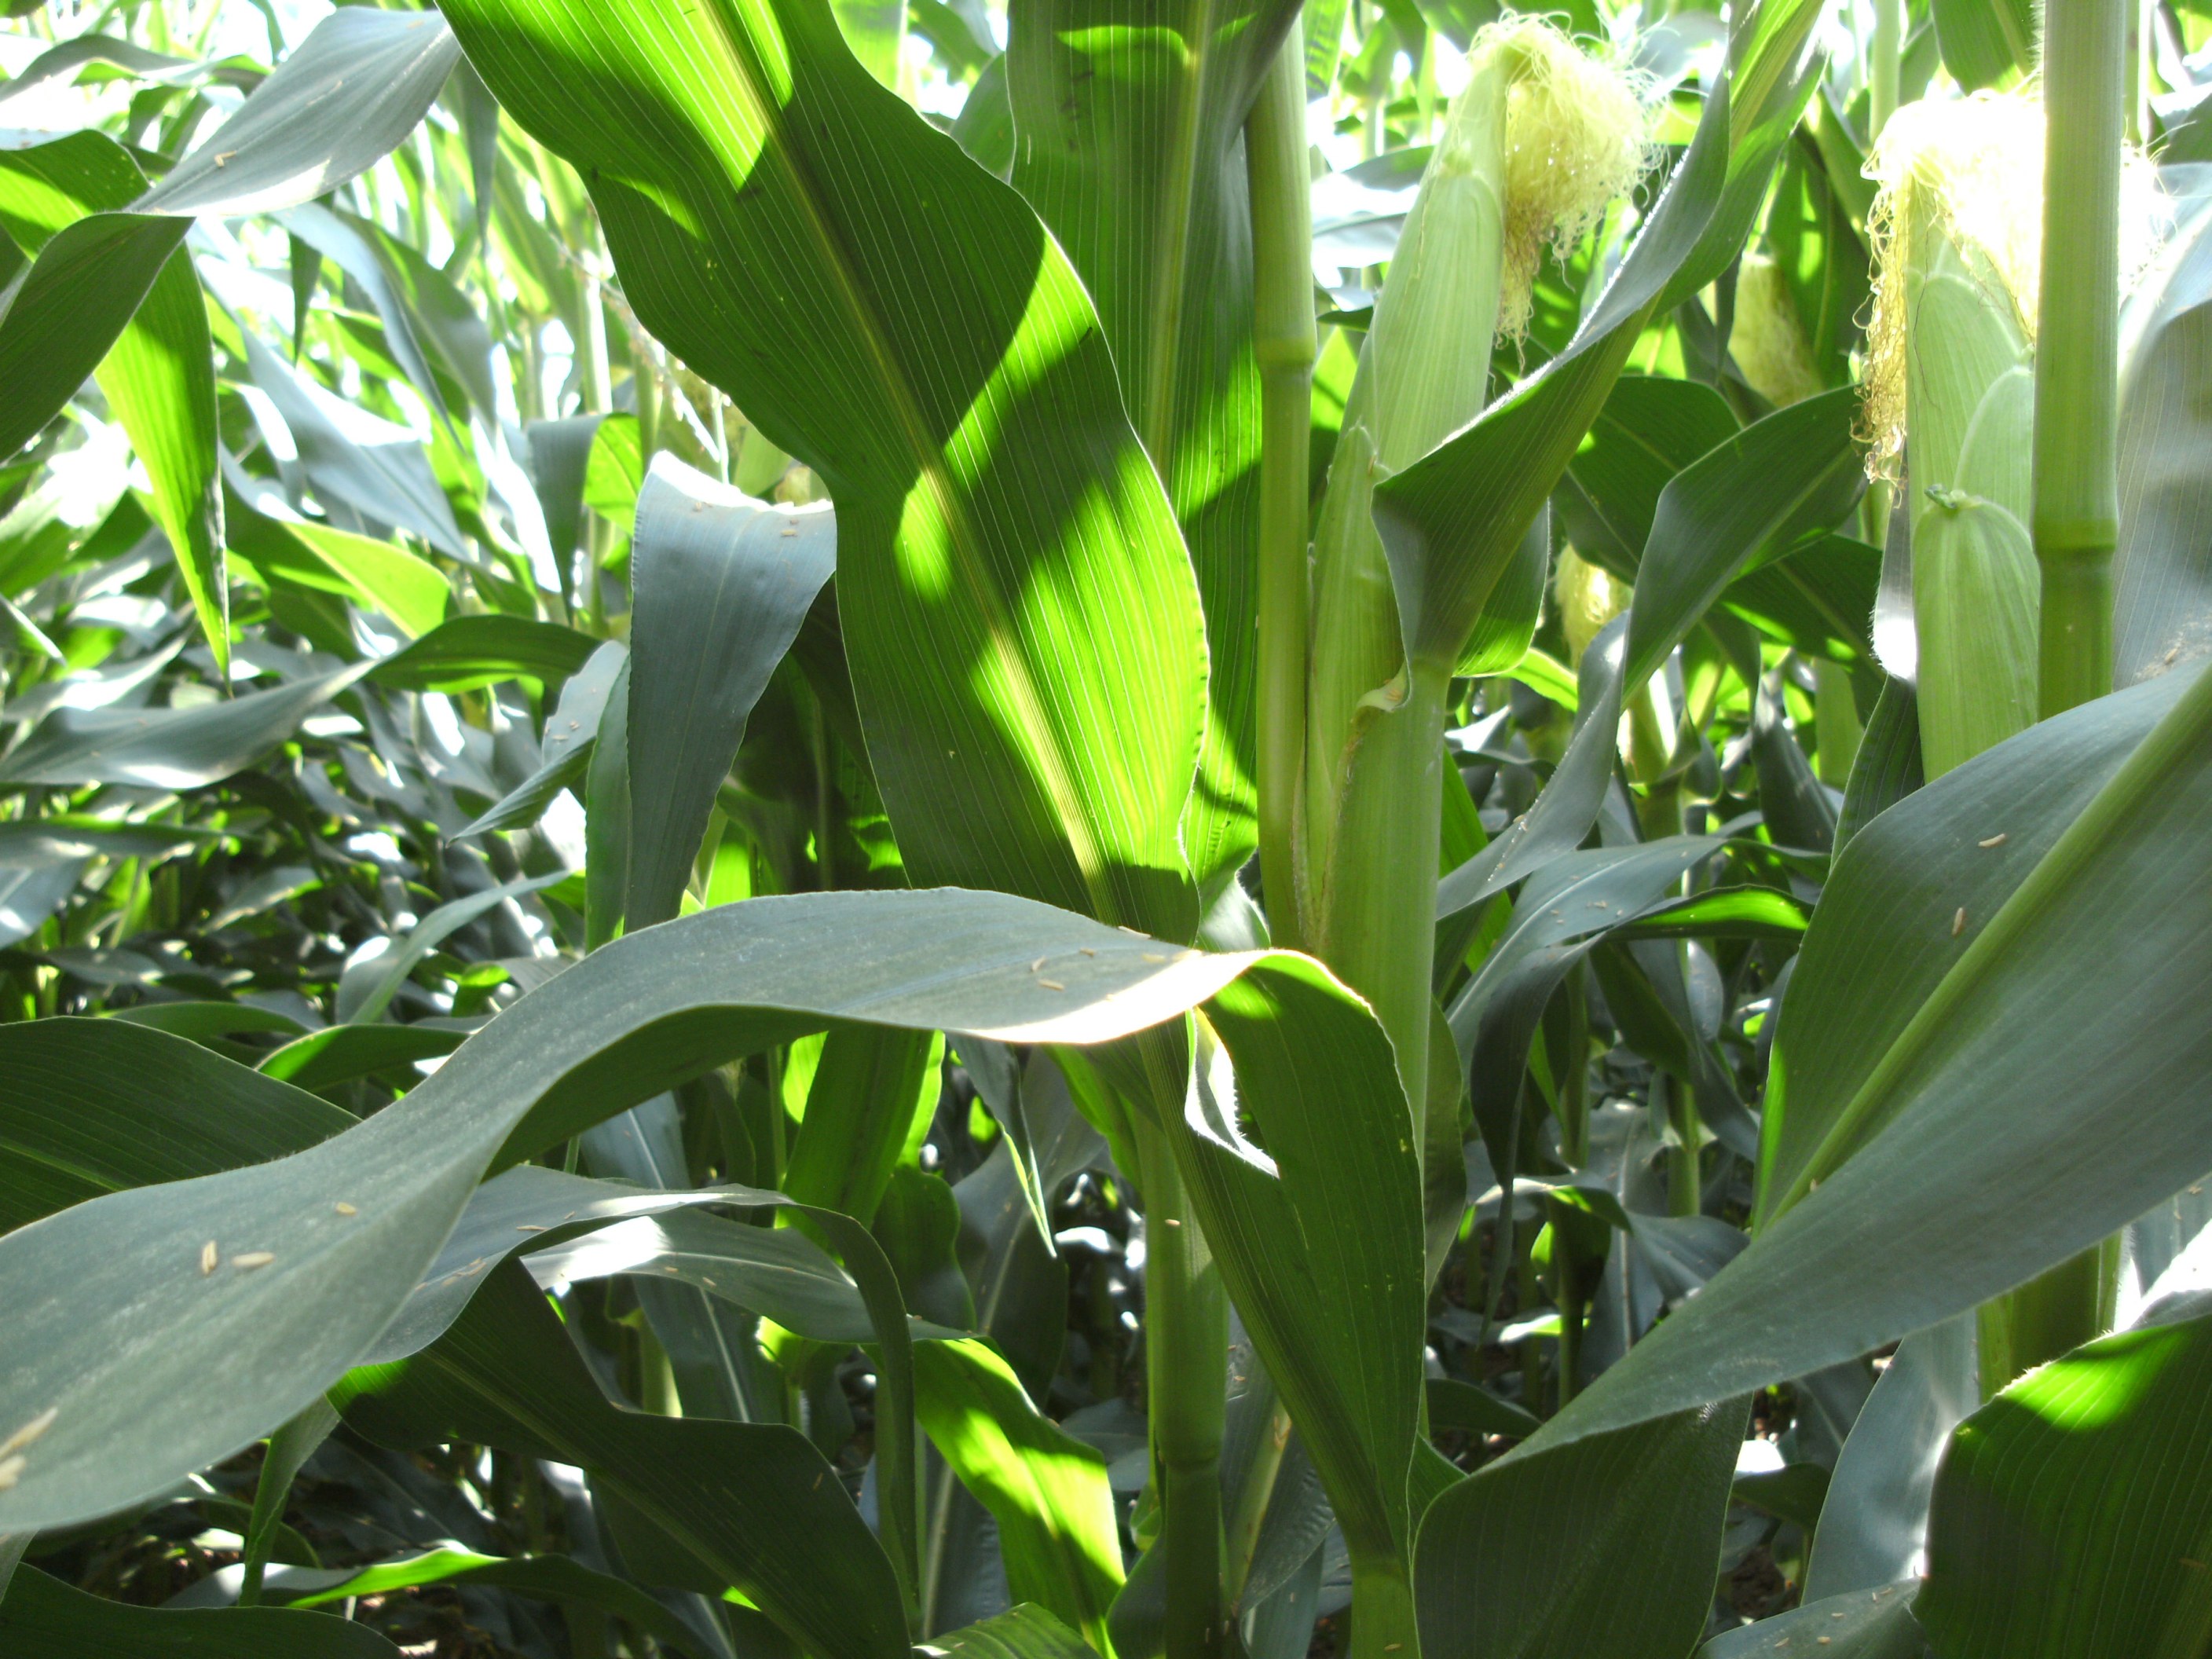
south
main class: Cropland
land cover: Maize
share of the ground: > 75 %
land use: Agriculture (excluding fallow land and kitchen gardens)
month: July
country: AT
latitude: 46.7833
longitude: 14.8316
